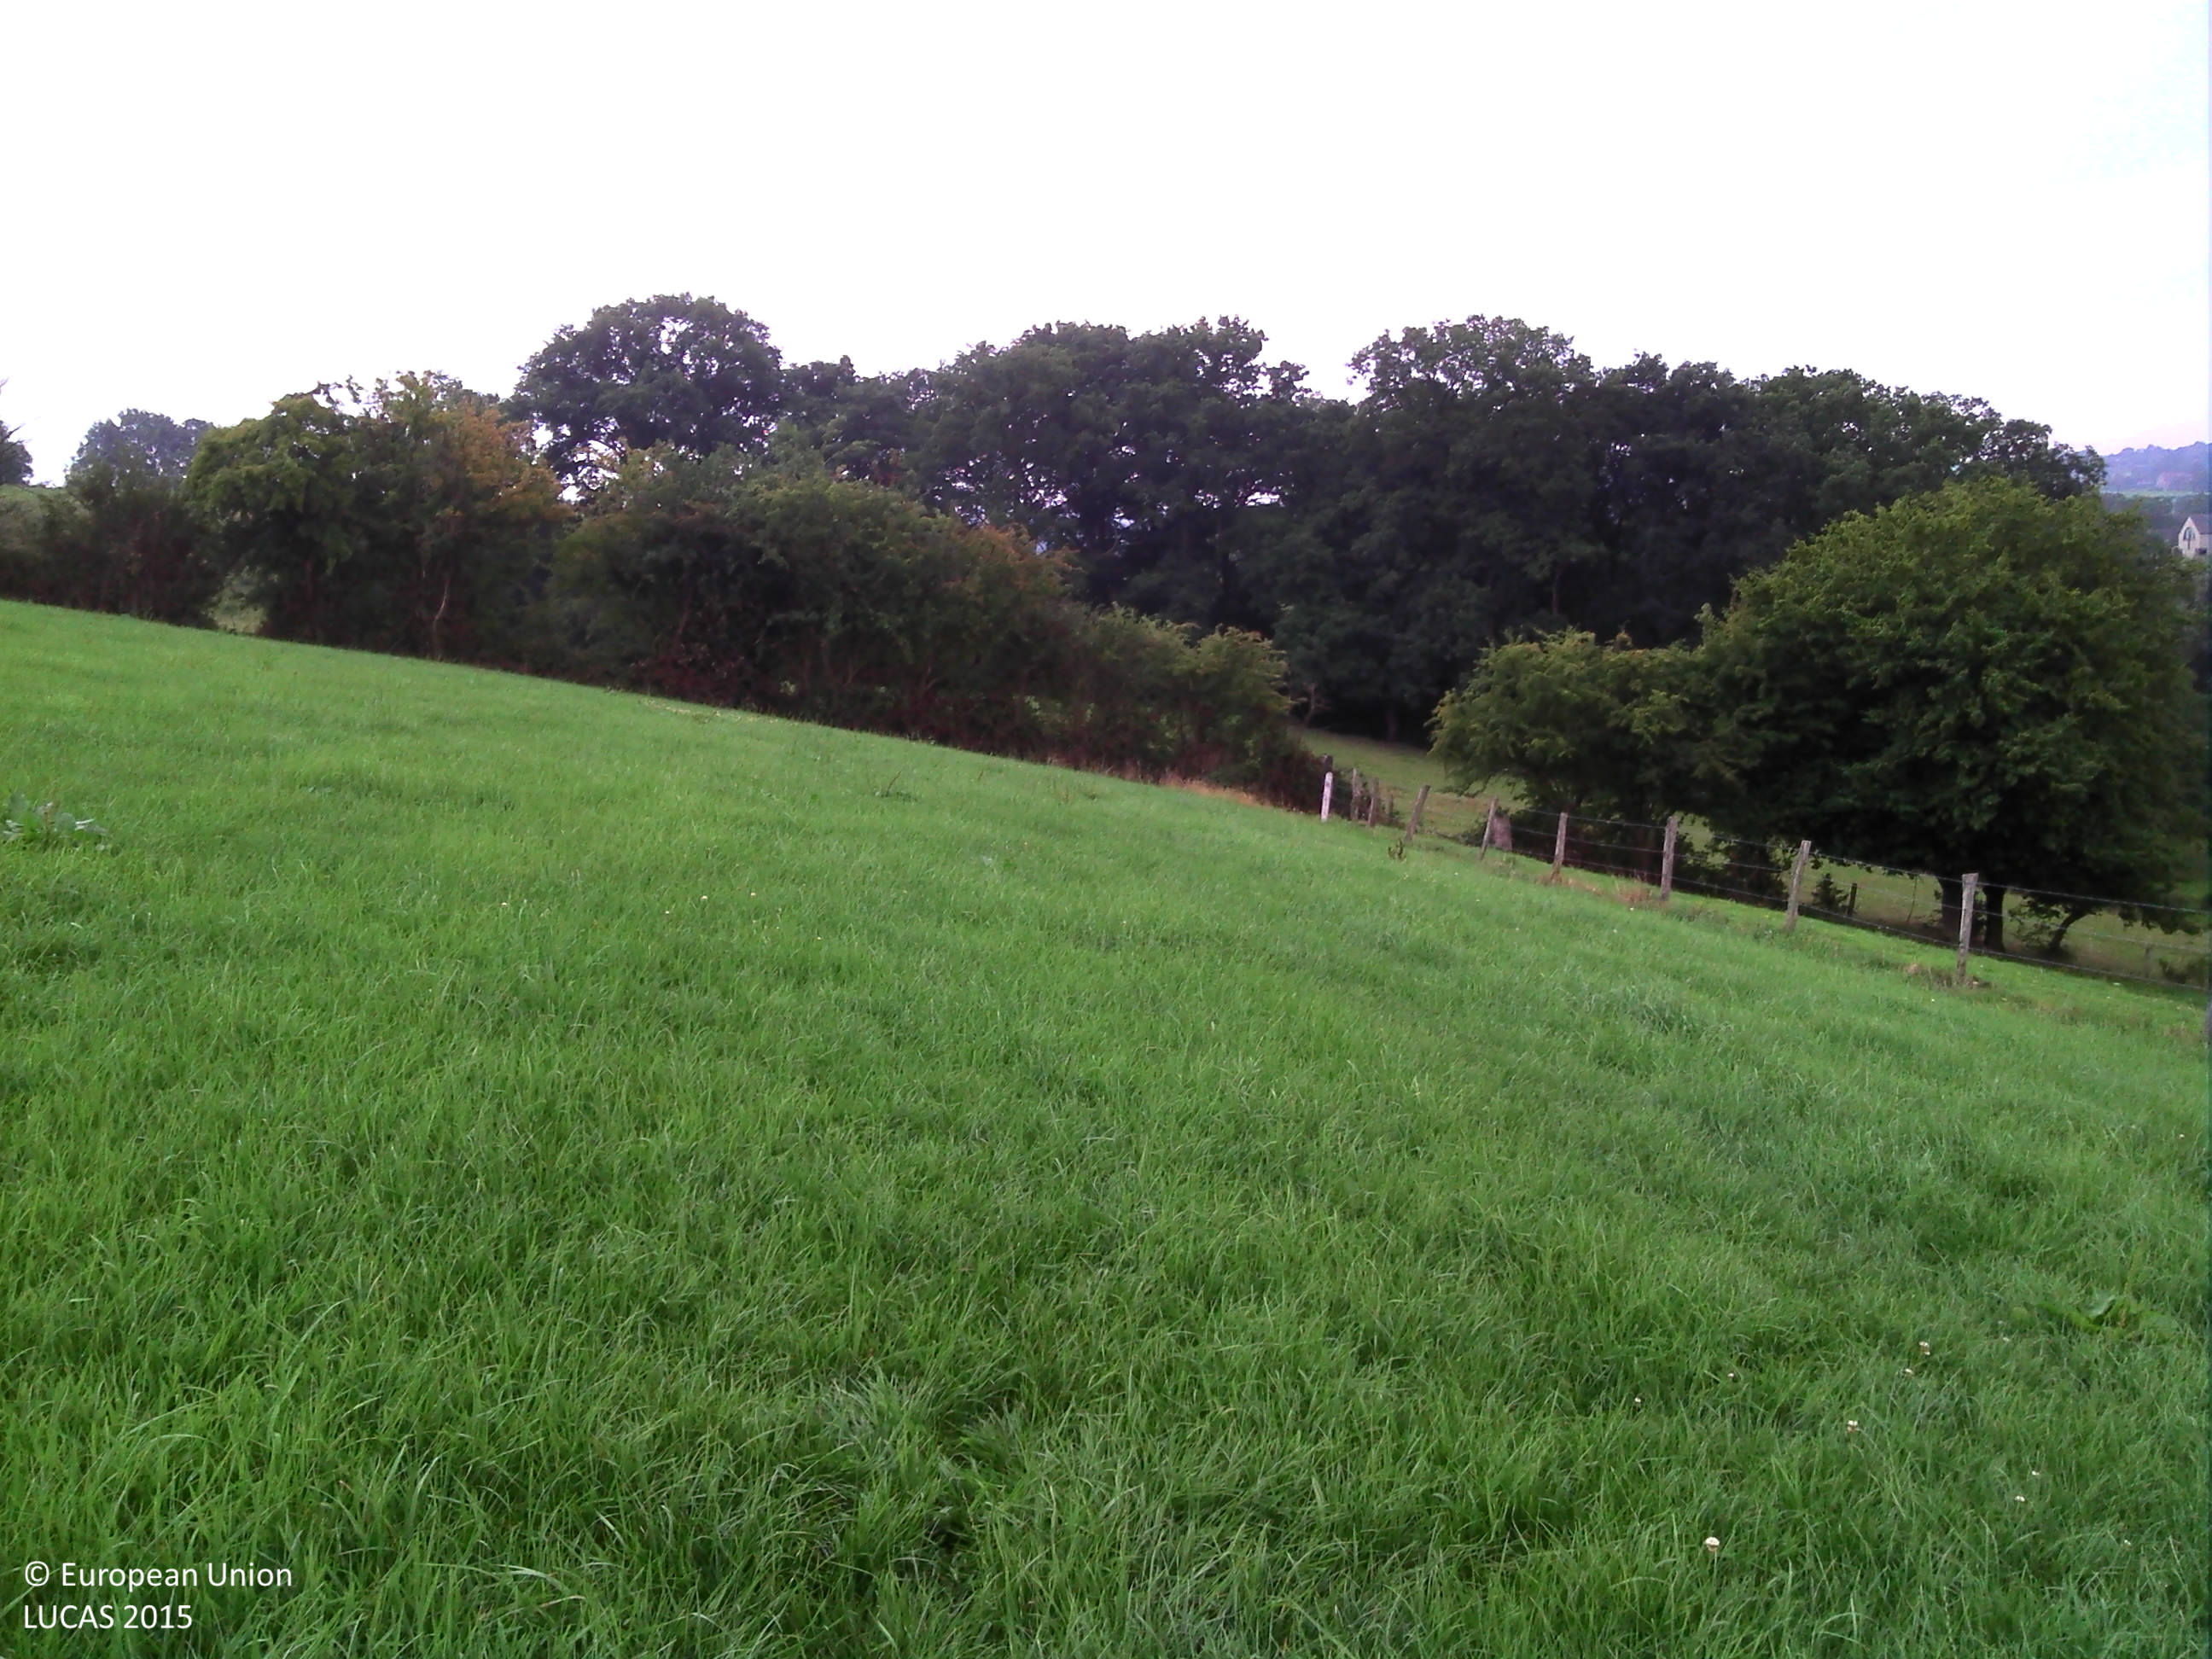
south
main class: Grassland
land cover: Grassland without tree/shrub cover
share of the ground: > 75 %
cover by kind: herbaceous plants 100 %
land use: Agriculture (excluding fallow land and kitchen gardens)
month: August
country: BE
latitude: 50.6670
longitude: 5.8533
